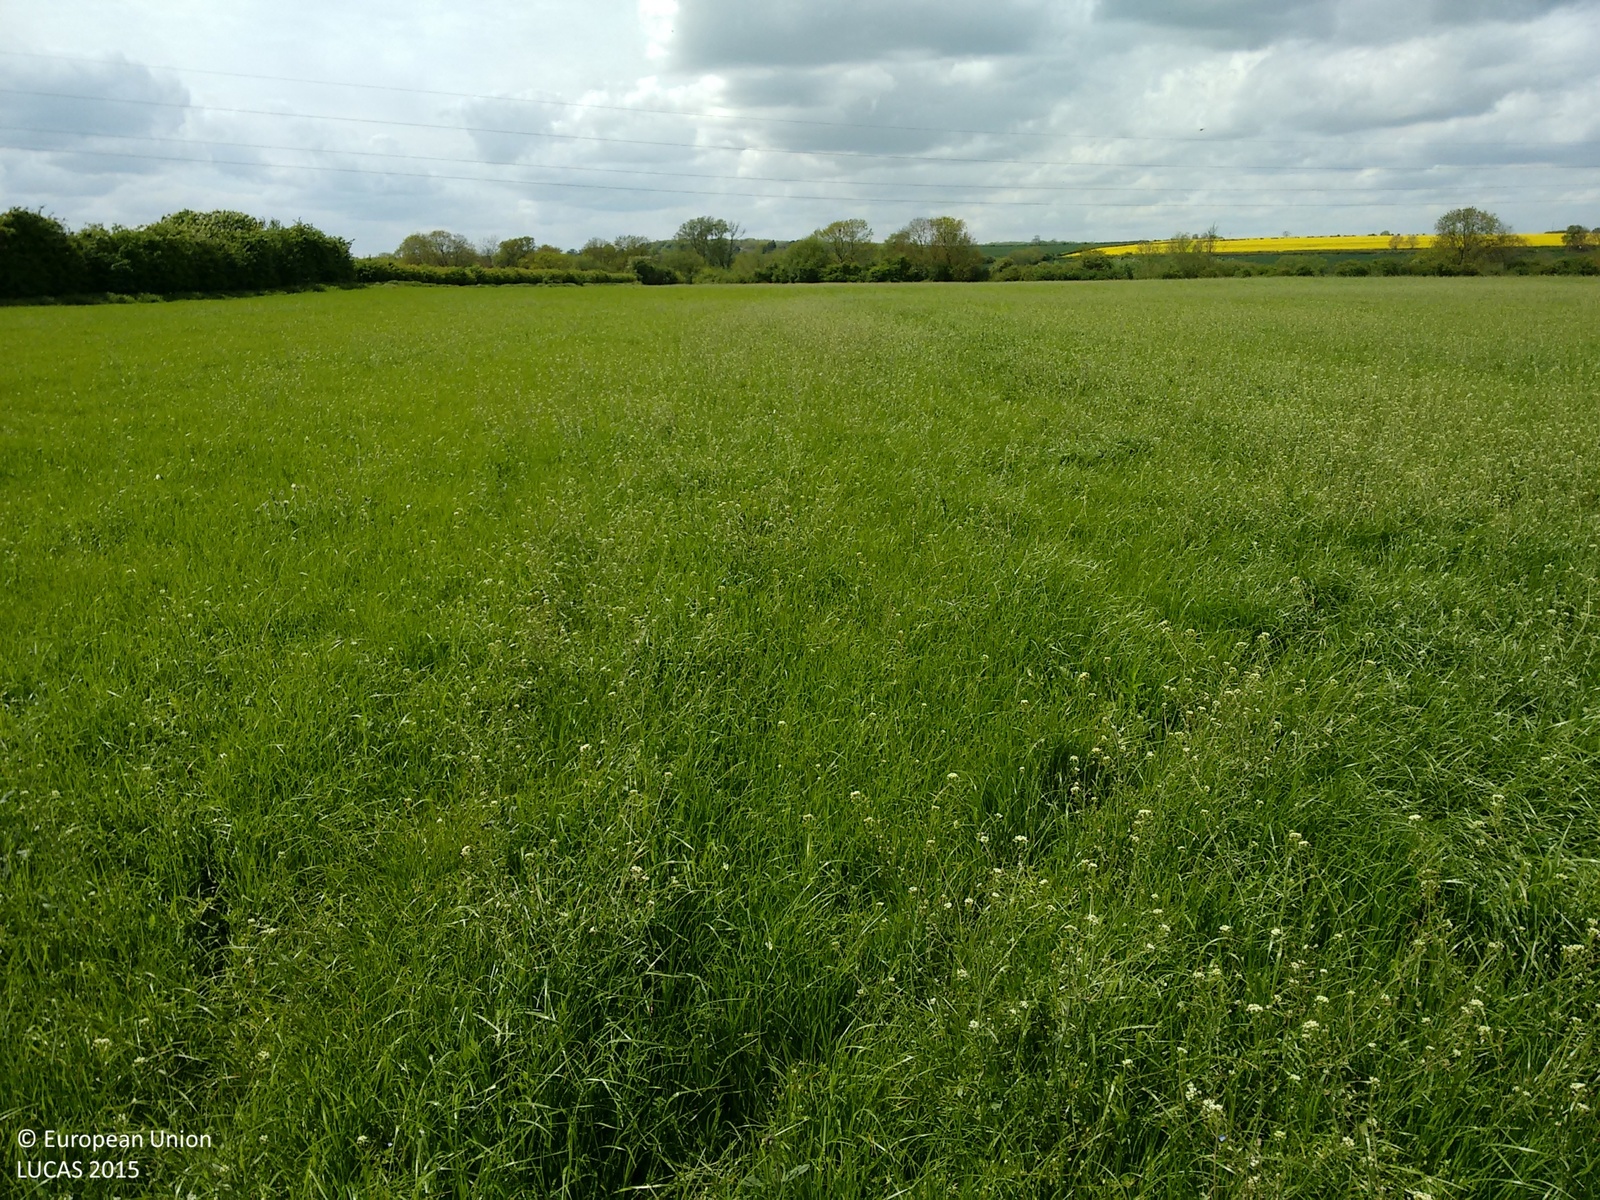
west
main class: Cropland
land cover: Temporary grasslands
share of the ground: > 75 %
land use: Agriculture (excluding fallow land and kitchen gardens)
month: May
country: GB
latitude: 52.1903
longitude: -0.6157
